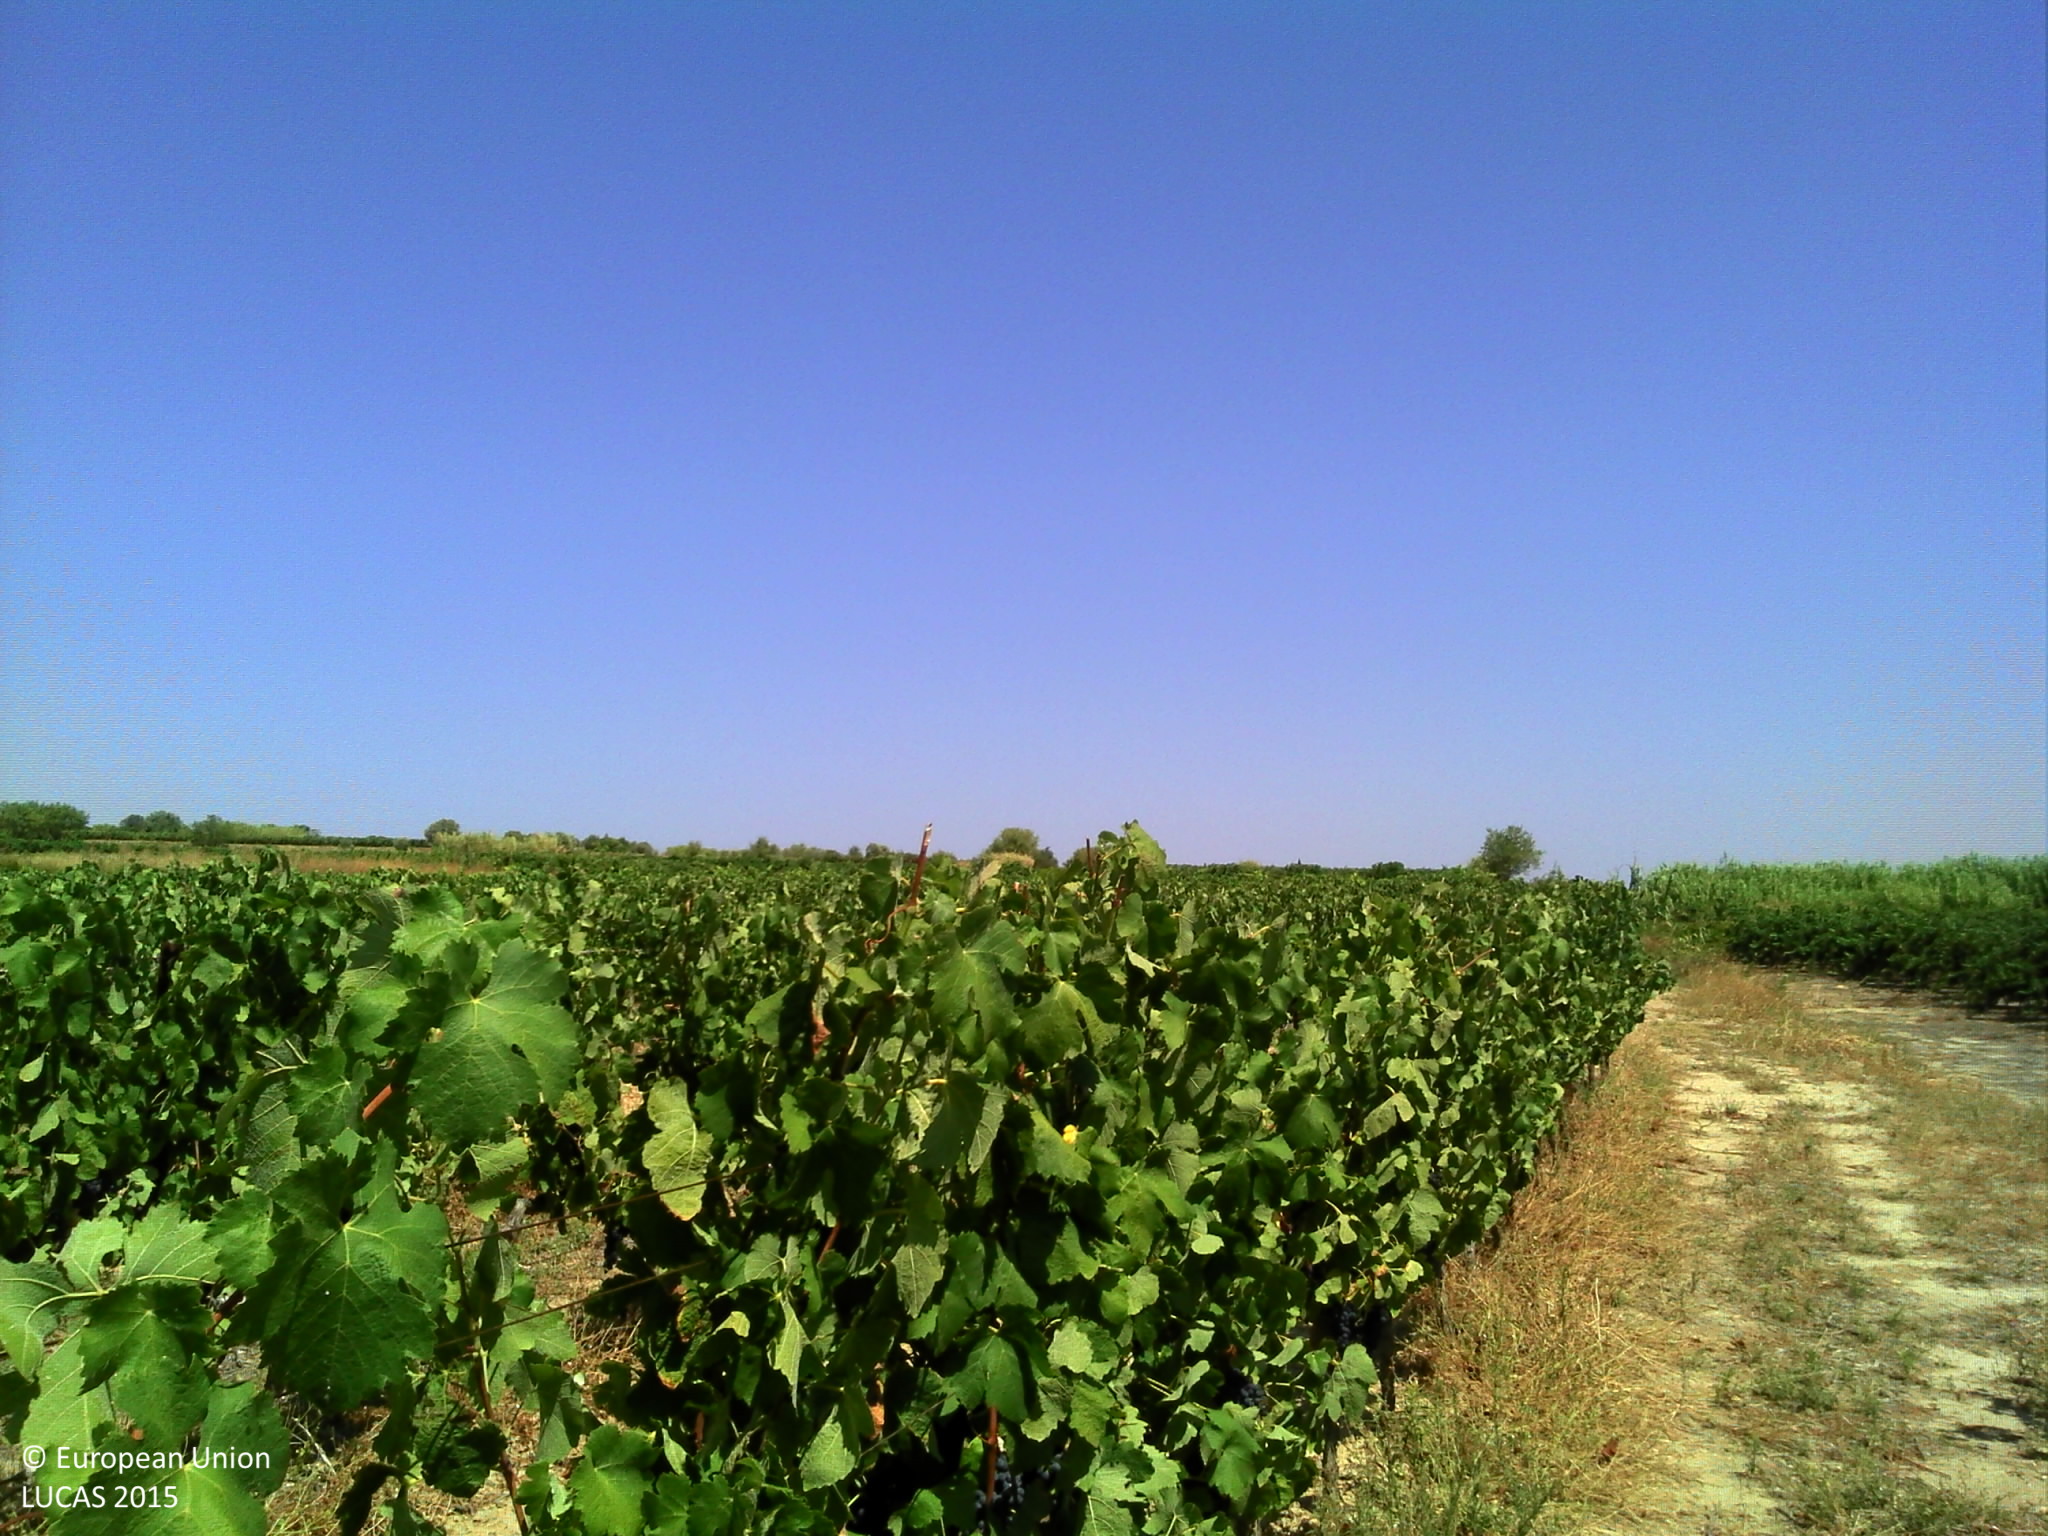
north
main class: Cropland
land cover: Vineyards
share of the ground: 10 - 25 %
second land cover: Other bare soil
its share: > 75 %
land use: Agriculture (excluding fallow land and kitchen gardens)
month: August
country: FR
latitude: 43.4330
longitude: 3.3753
